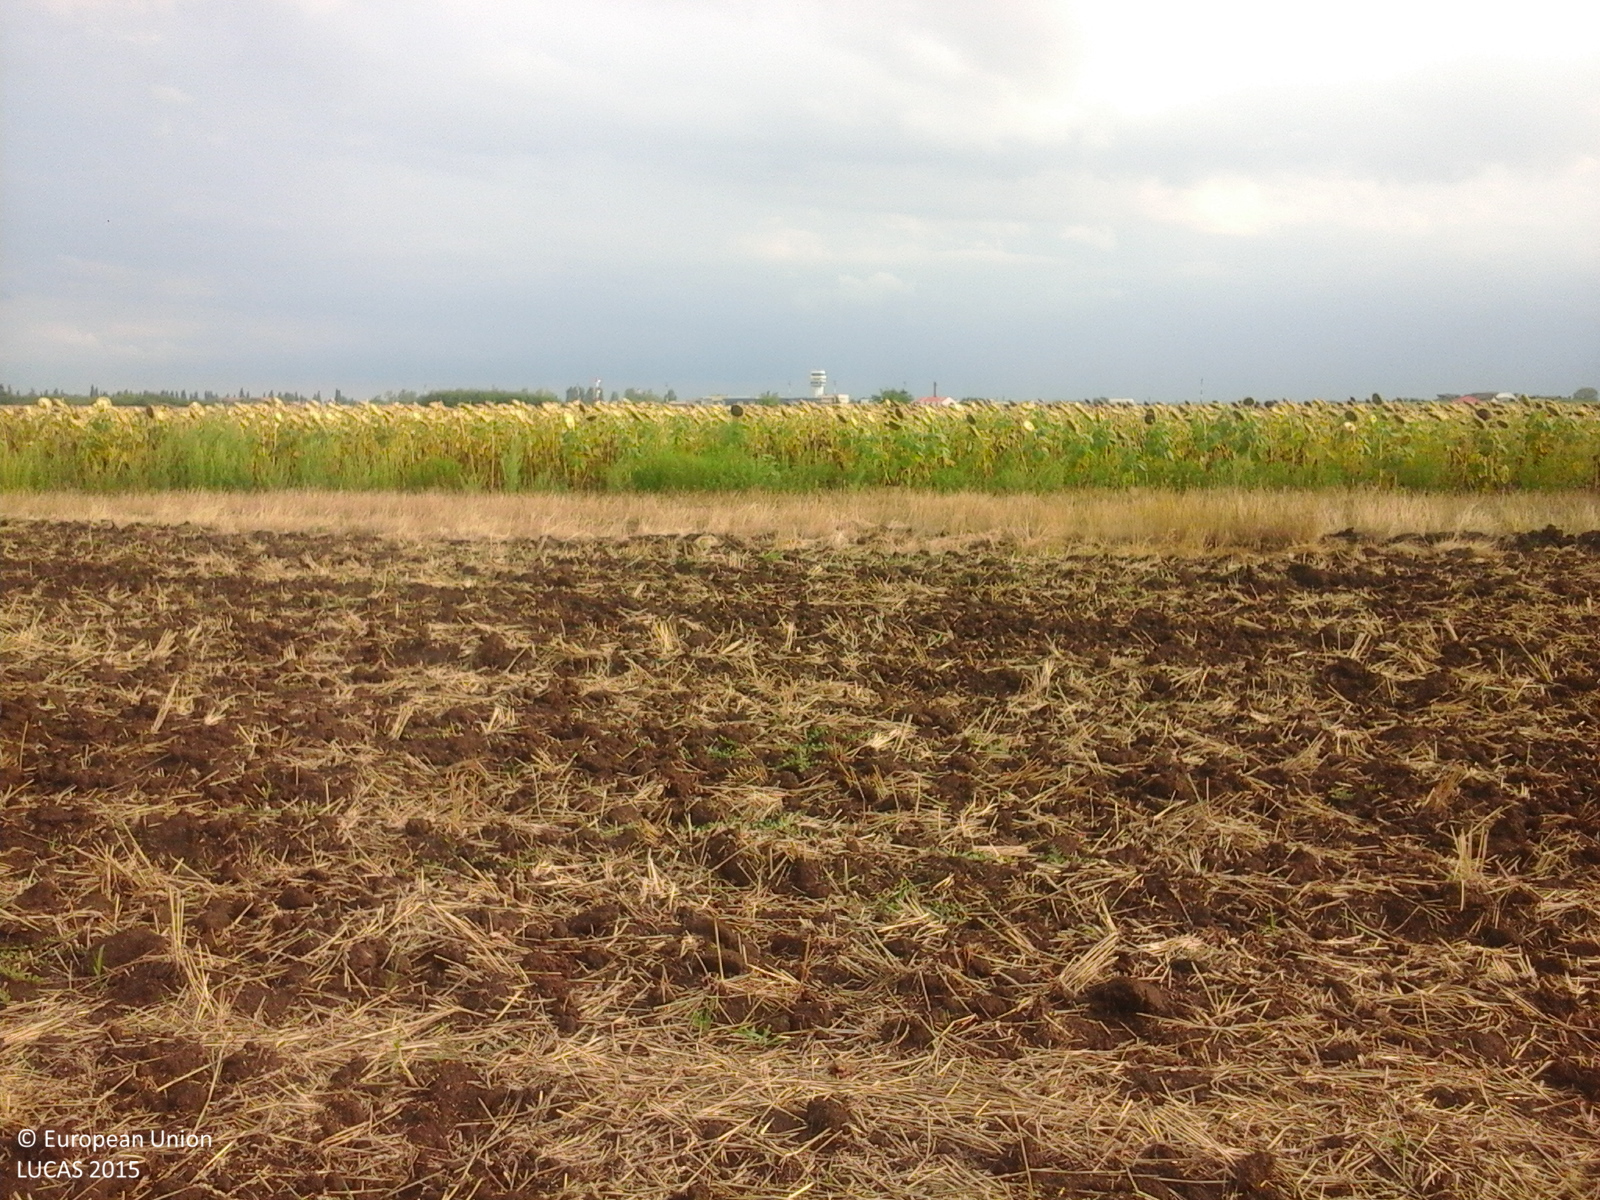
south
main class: Cropland
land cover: Common wheat
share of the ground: 25 - 50 %
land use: Agriculture (excluding fallow land and kitchen gardens)
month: August
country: RO
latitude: 45.8209
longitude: 21.3198
